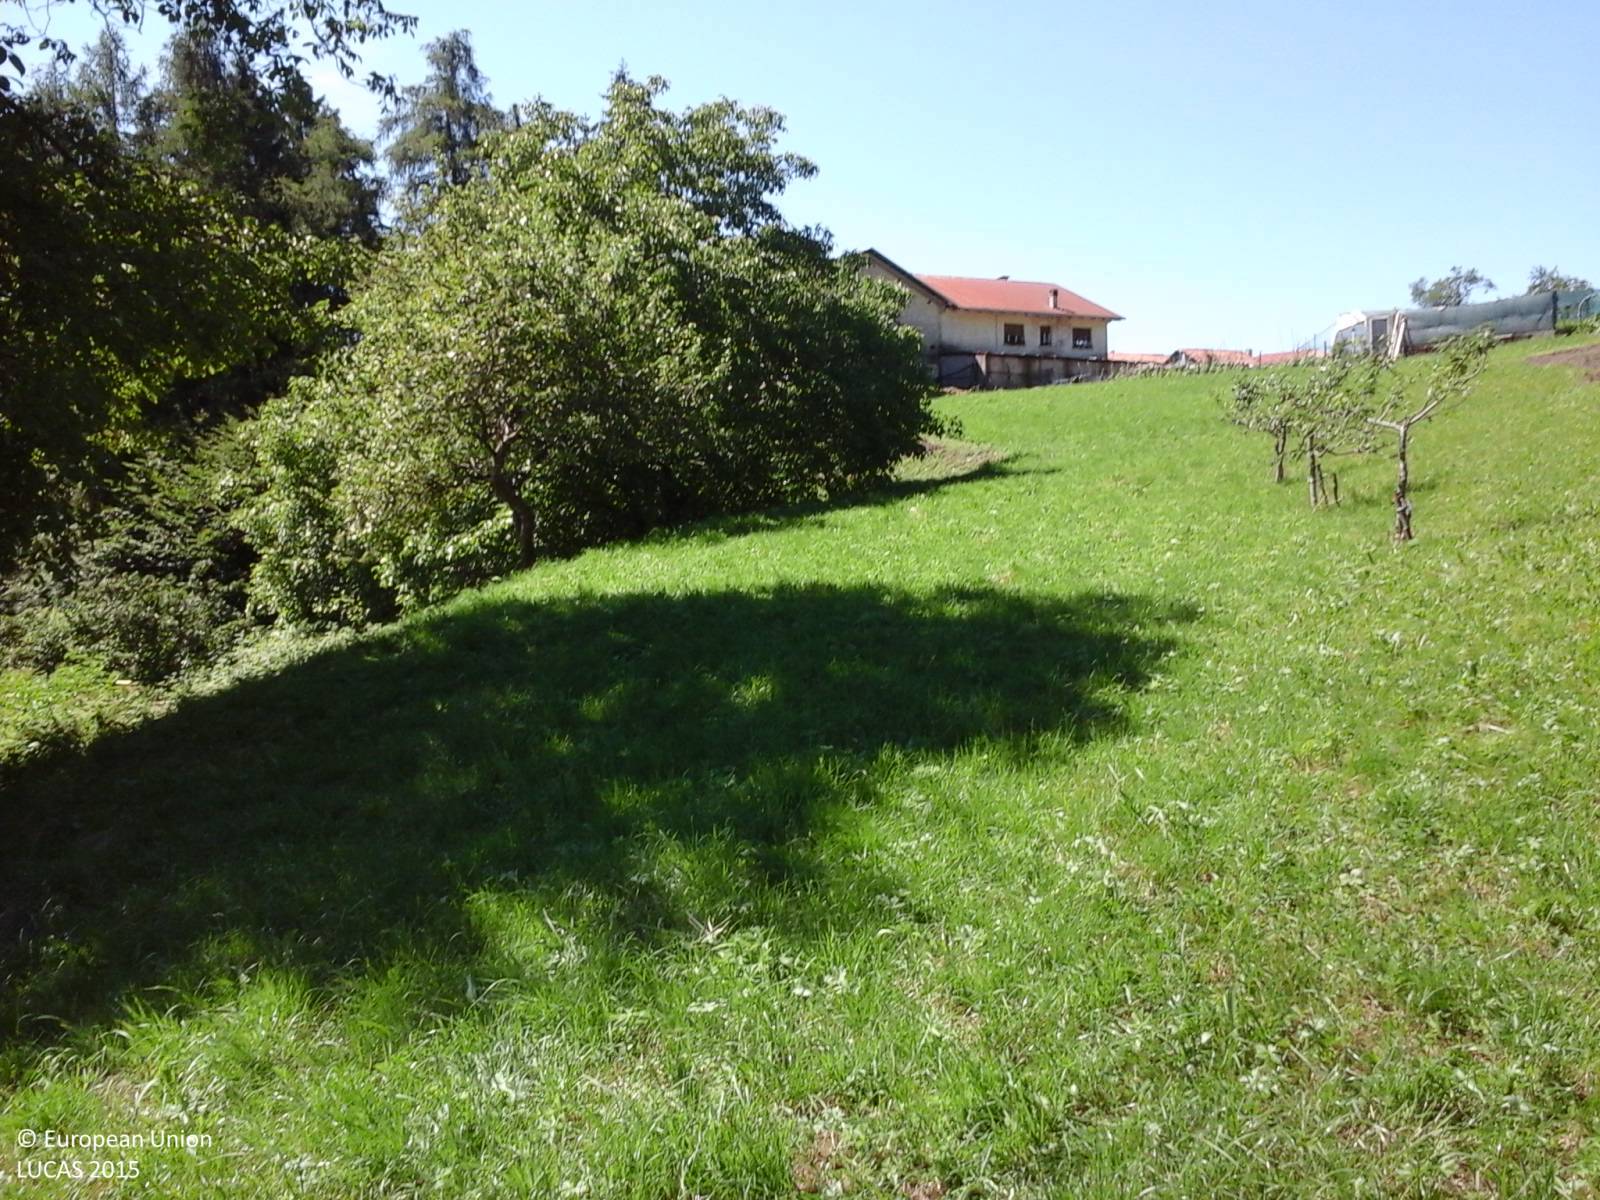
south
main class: Grassland
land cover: Grassland without tree/shrub cover
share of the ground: > 75 %
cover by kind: herbaceous plants 100 %
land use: Agriculture (excluding fallow land and kitchen gardens)
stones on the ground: < 10 %
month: June
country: IT
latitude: 46.4870
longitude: 13.0845
